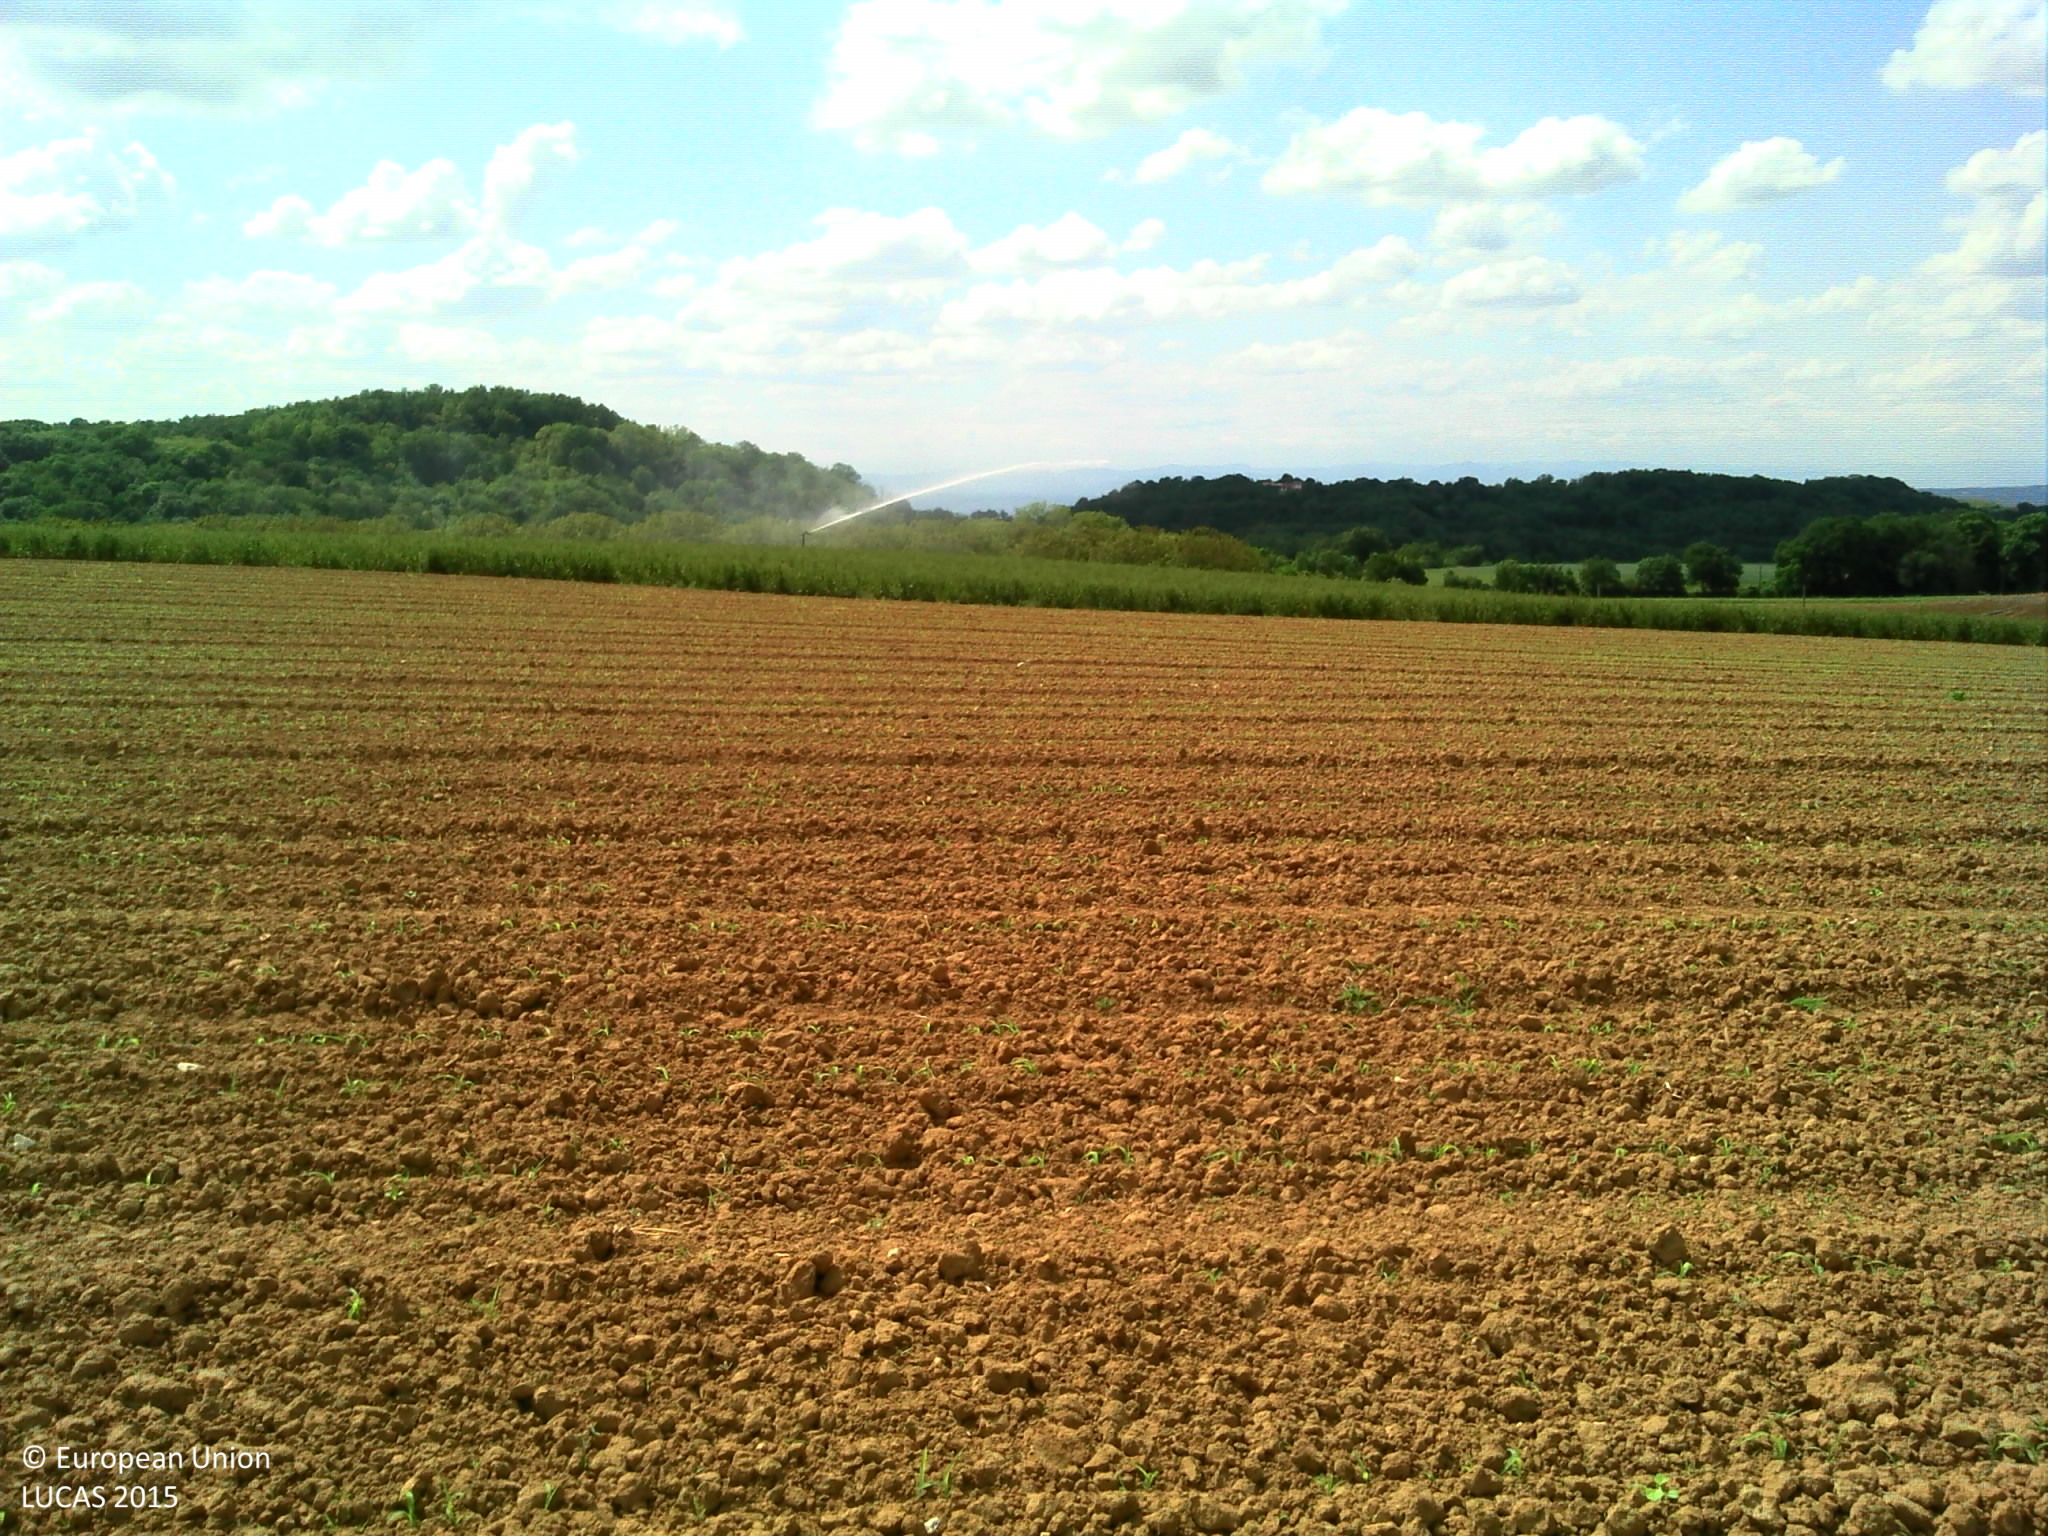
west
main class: Cropland
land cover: Maize
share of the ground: < 10 %
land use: Agriculture (excluding fallow land and kitchen gardens)
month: May
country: FR
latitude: 45.0136
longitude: 5.1458
